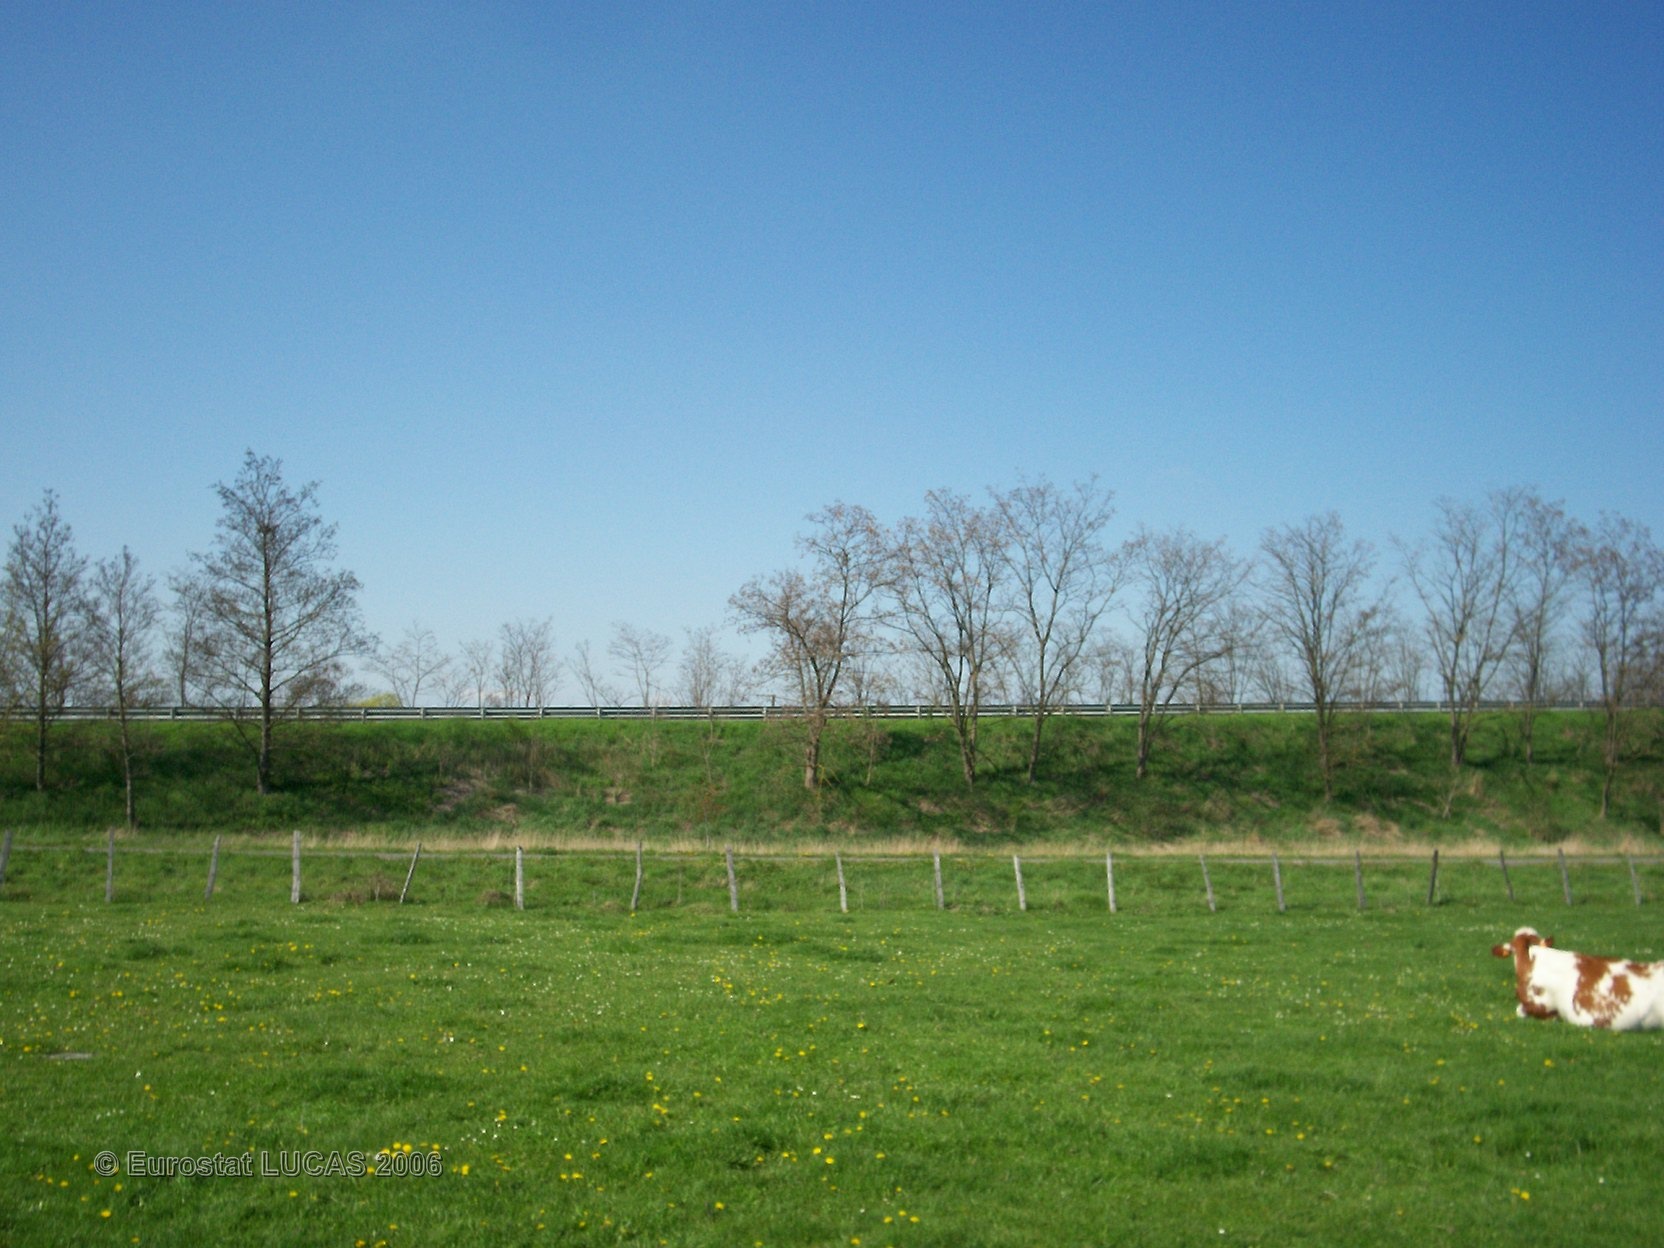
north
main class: Grassland
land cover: Grassland without tree/shrub cover
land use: Agriculture (excluding fallow land and kitchen gardens)
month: April
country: FR
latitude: 45.6335
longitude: 4.1919
